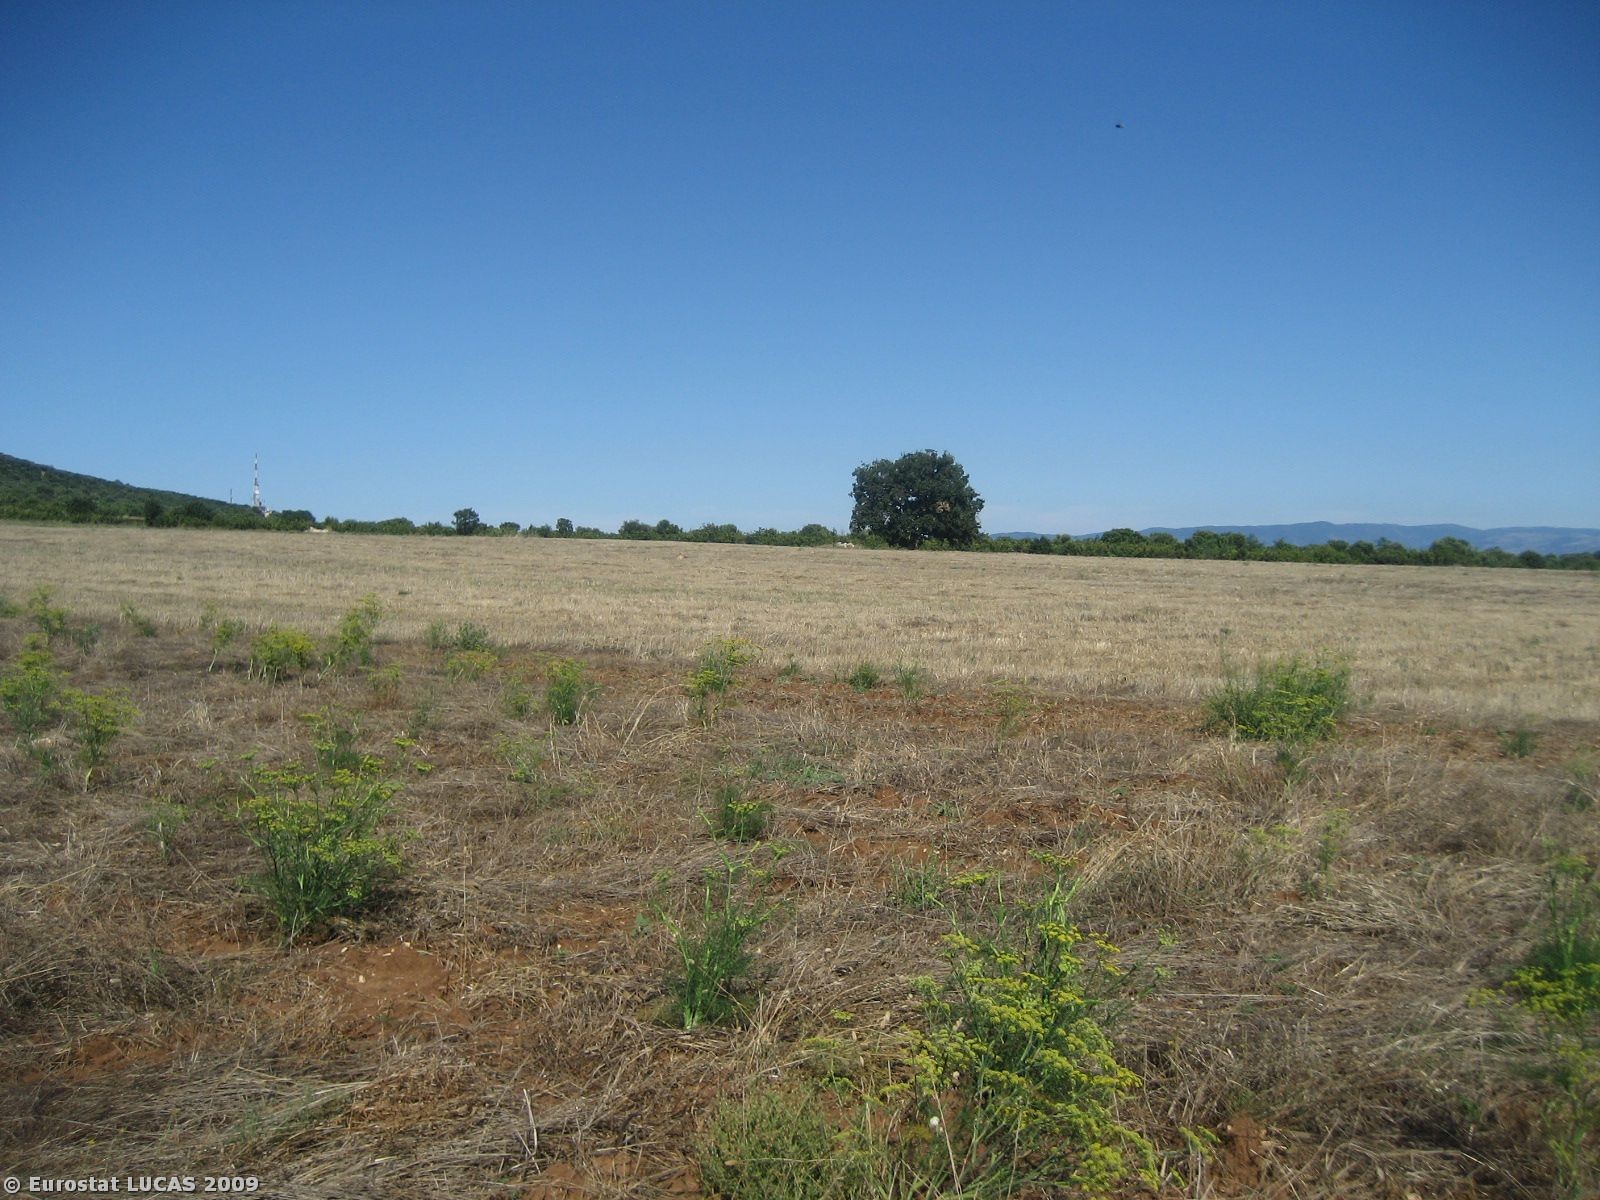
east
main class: Grassland
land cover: Spontaneously vegetated surfaces
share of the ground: > 75 %
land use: Fallow land
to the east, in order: Spontaneously vegetated surfaces; Durum wheat
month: July
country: IT
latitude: 41.8995
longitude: 15.6370
